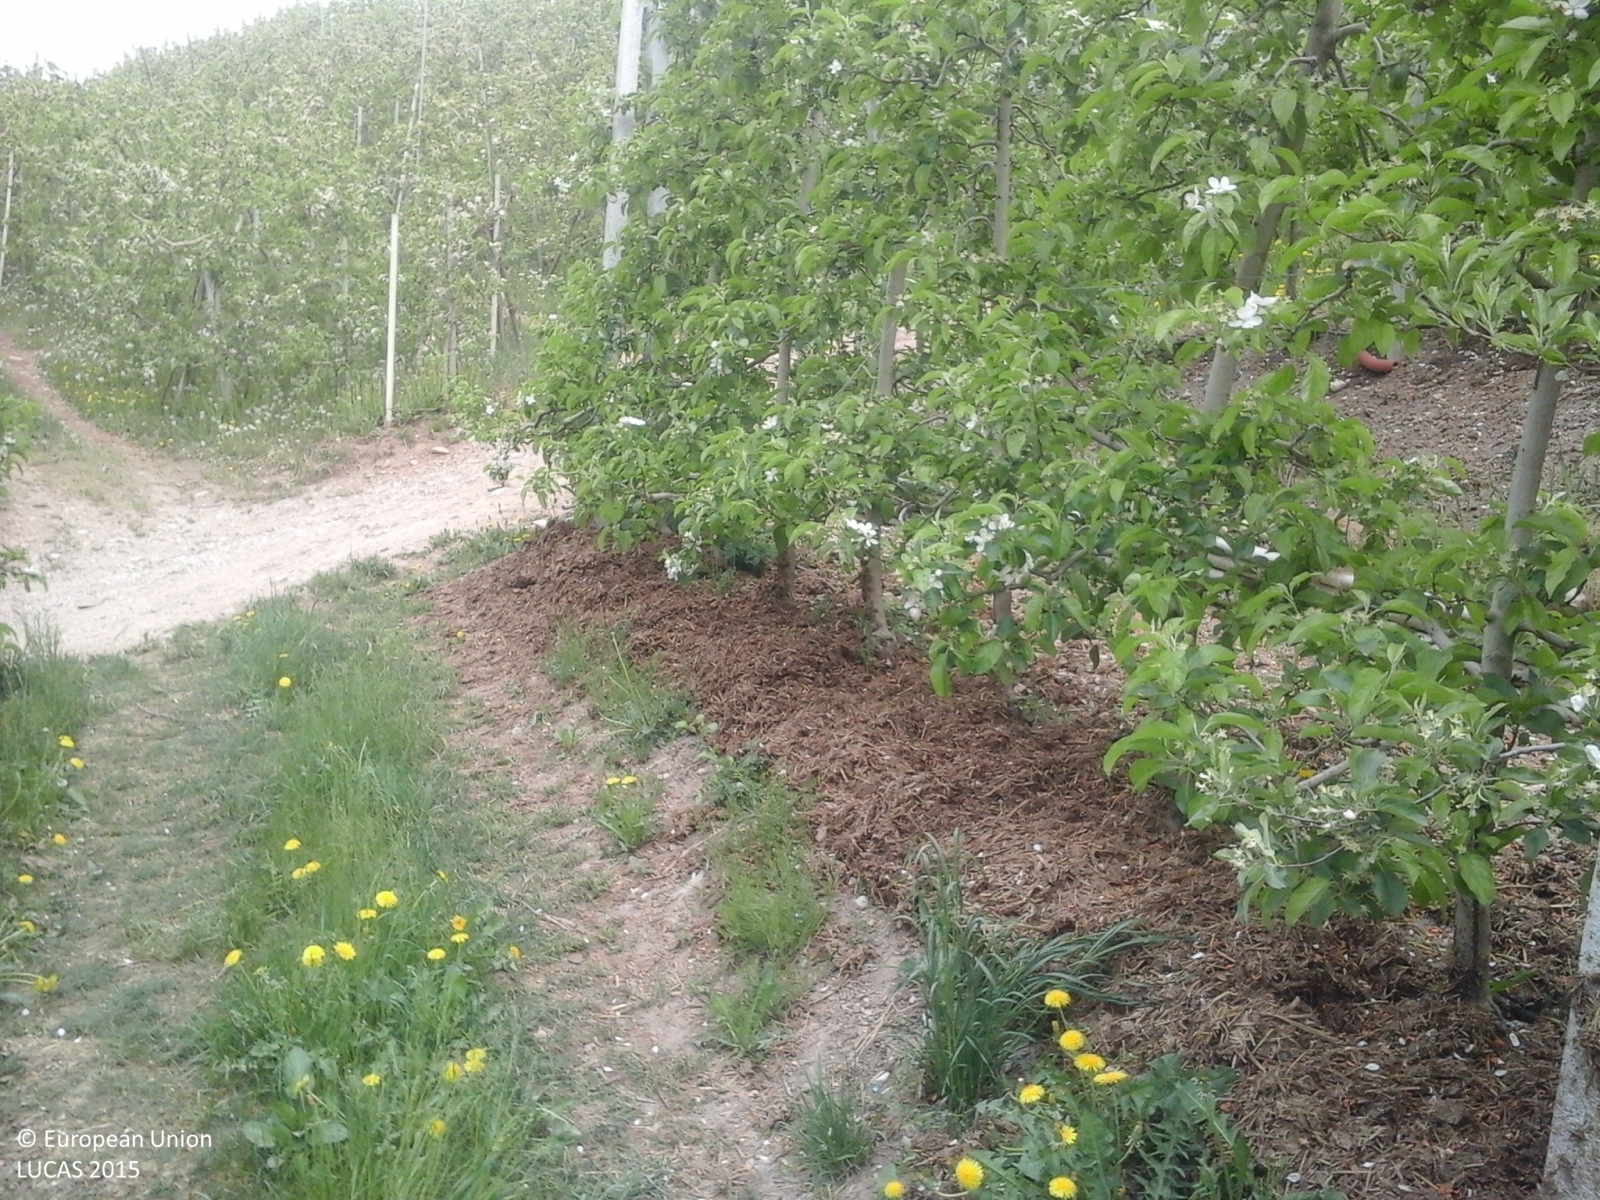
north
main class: Cropland
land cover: Apple fruit
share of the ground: 25 - 50 %
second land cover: Grassland without tree/shrub cover
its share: > 75 %
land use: Agriculture (excluding fallow land and kitchen gardens)
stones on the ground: < 10 %
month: April
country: IT
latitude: 46.3098
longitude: 11.0763
